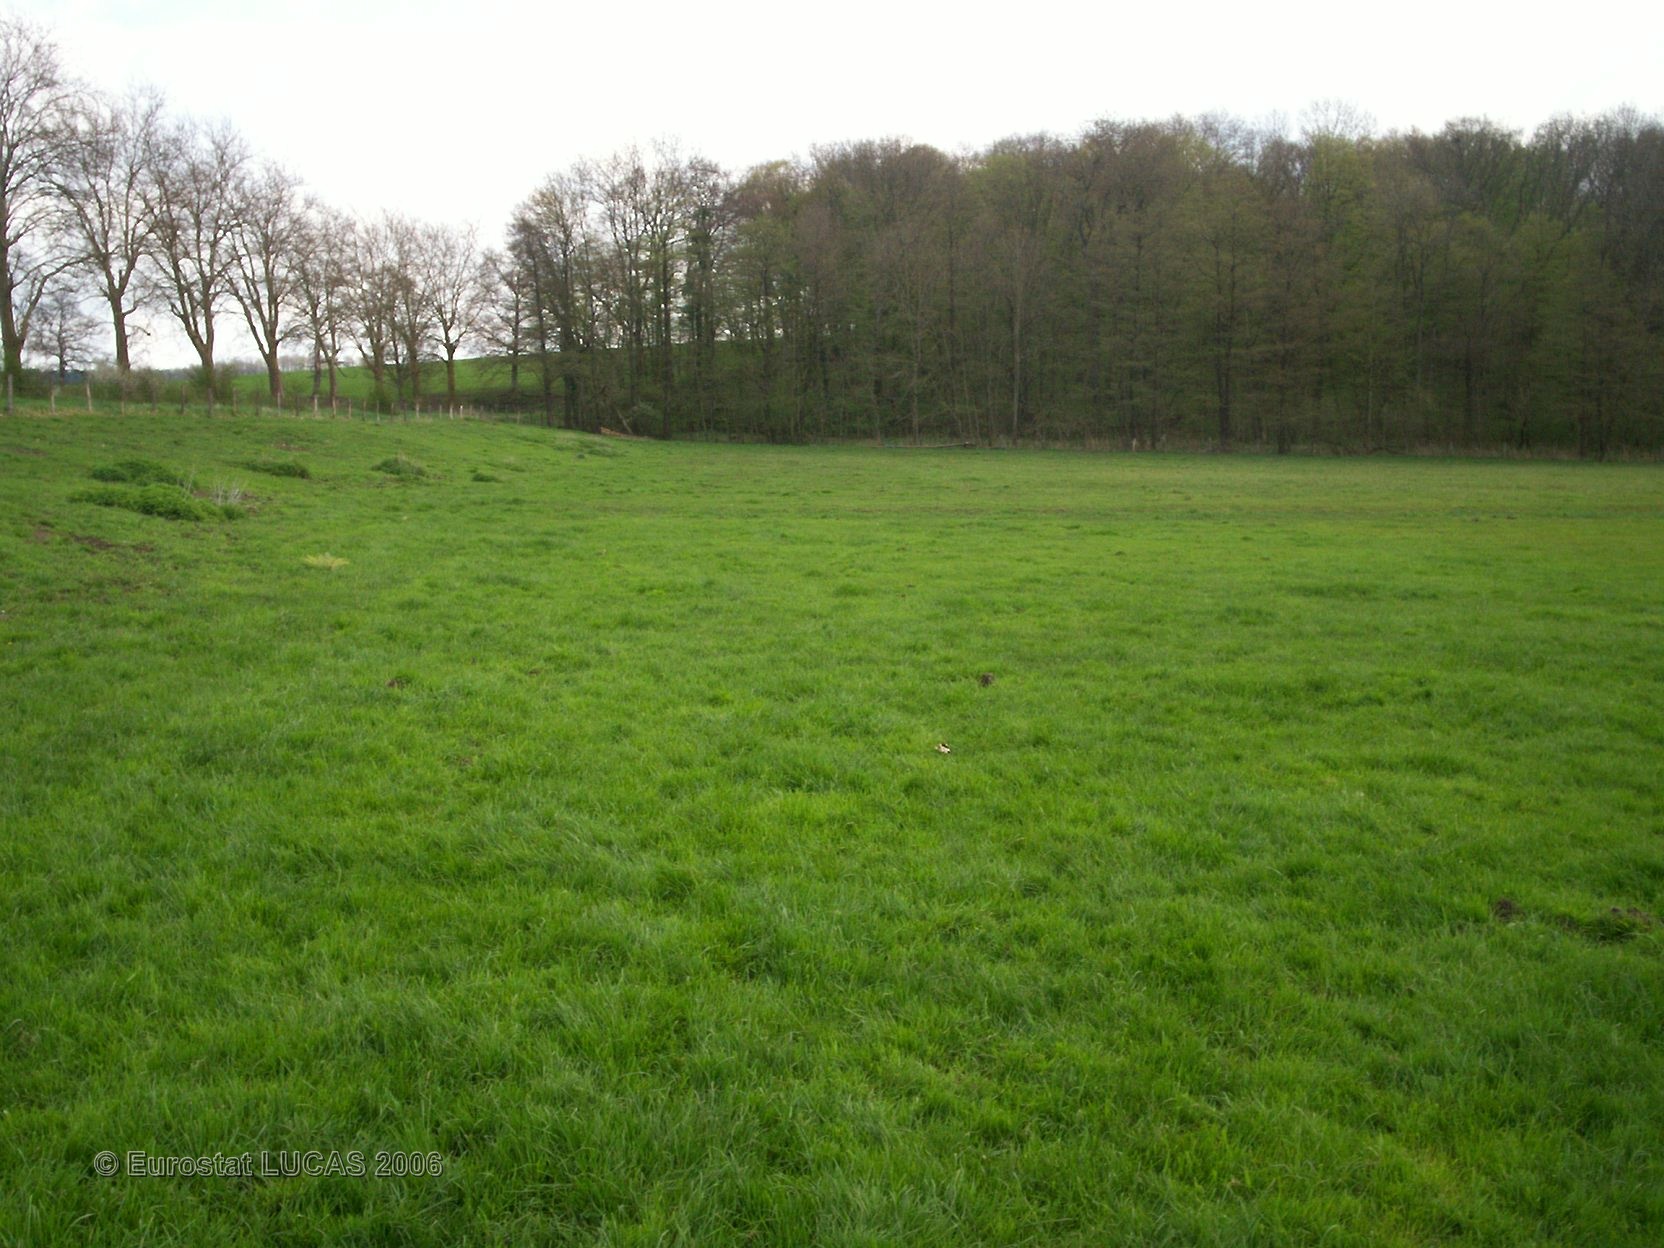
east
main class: Grassland
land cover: Grassland without tree/shrub cover
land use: Agriculture (excluding fallow land and kitchen gardens)
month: April
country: FR
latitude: 48.6996
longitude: 6.8075
